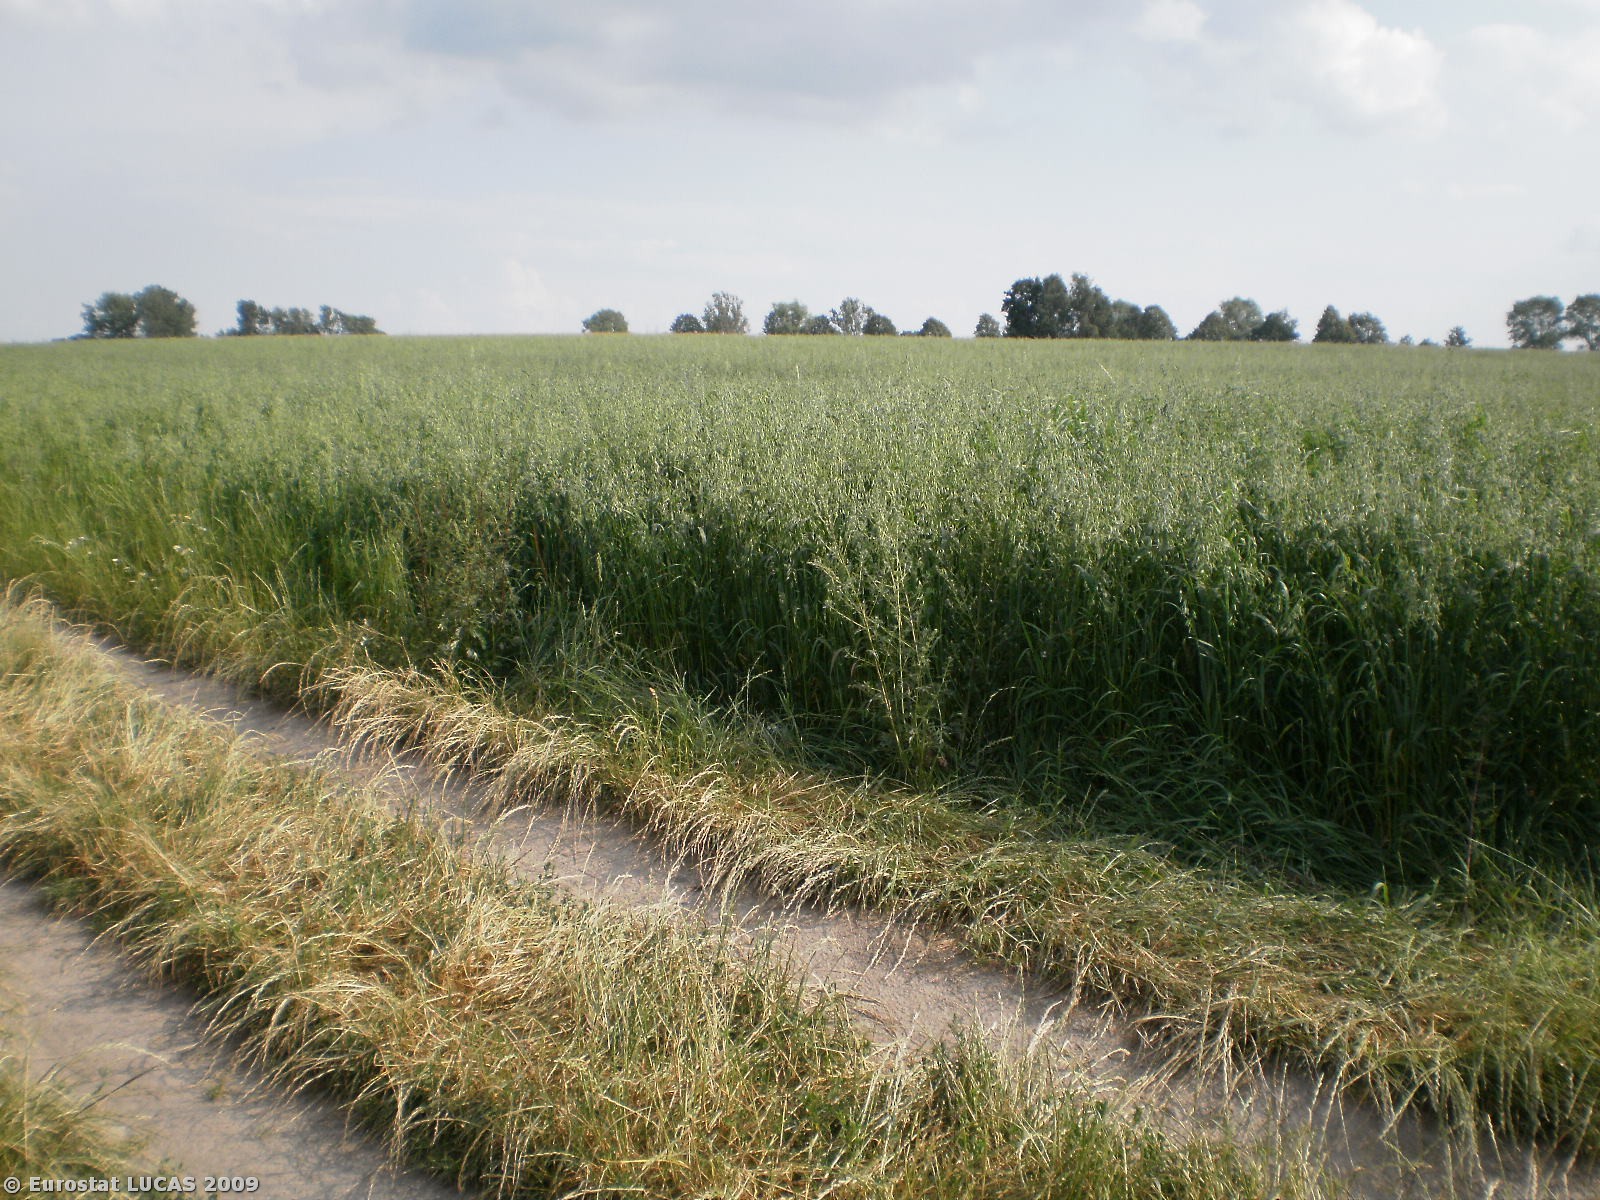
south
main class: Grassland
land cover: Grassland without tree/shrub cover
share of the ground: > 75 %
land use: Agriculture (excluding fallow land and kitchen gardens)
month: July
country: PL
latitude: 53.2893
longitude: 20.4932
